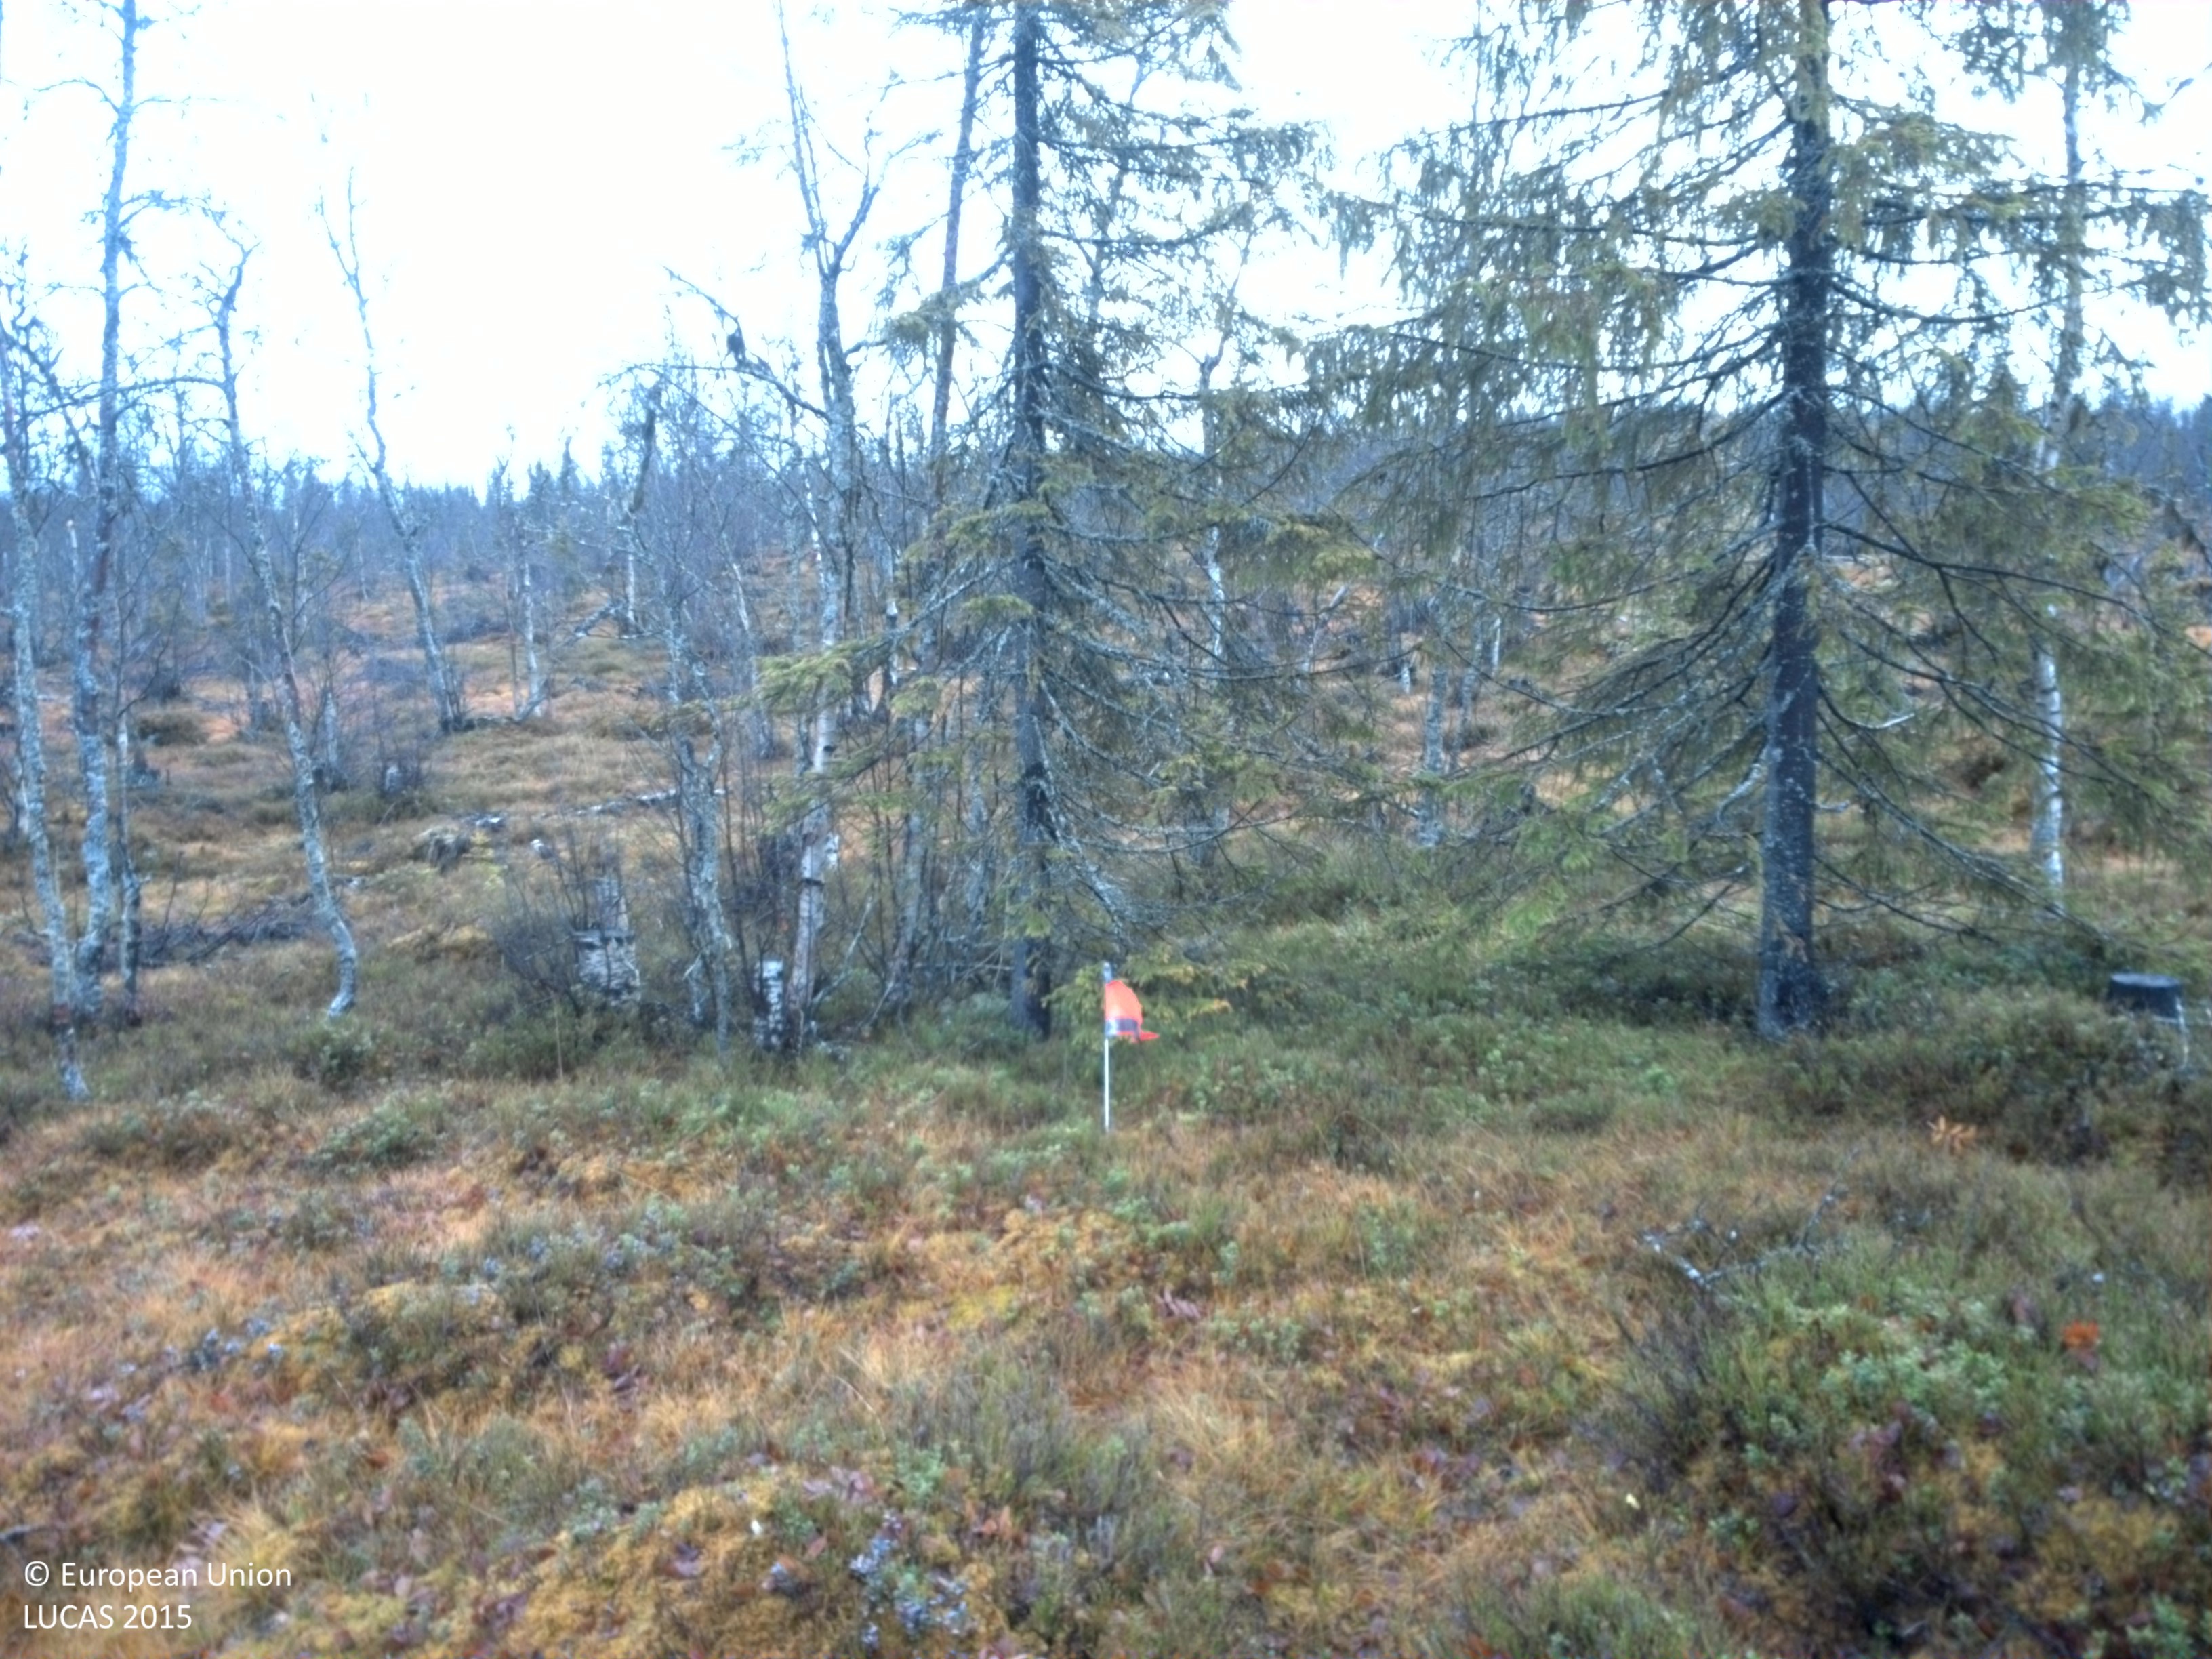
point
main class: Woodland
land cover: Spruce dominated mixed woodland
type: boreal forest
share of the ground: 10 - 25 %
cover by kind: shrubs 40 %, lichens and mosses 25 %, herbaceous plants 20 %, broadleaved forest trees 10 %, coniferous forest trees 5 %
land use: Forestry
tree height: > 5 m
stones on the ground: < 10 %
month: October
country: SE
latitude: 64.5220
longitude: 17.6553
